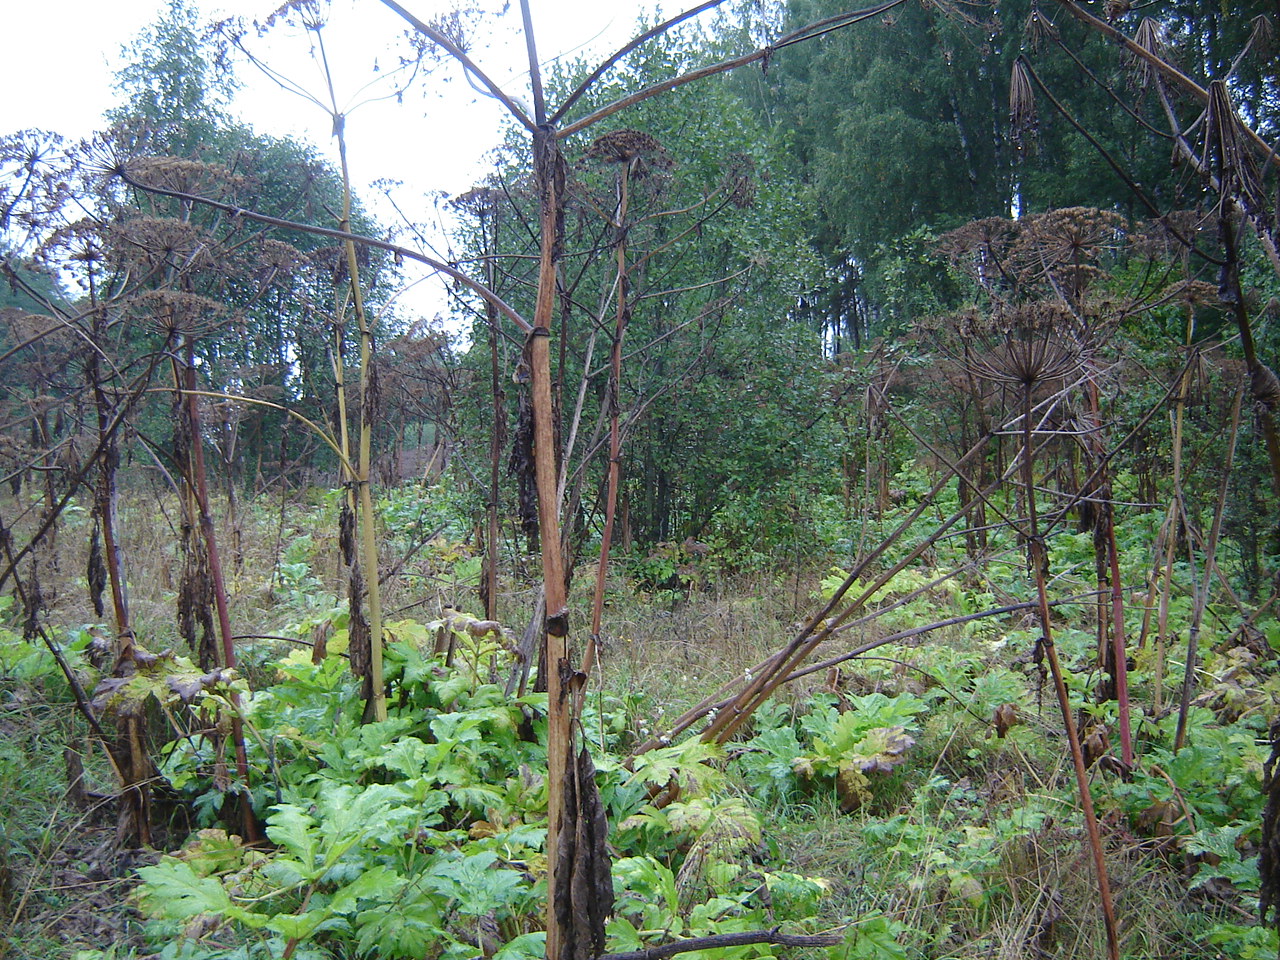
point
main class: Woodland
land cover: Pine dominated mixed woodland
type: hemiboreal forest and nemoral coniferous forest and mixed broadleaved-coniferous forest
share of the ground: > 75 %
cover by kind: broadleaved forest trees 55 %, coniferous forest trees 30 %, herbaceous plants 15 %
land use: Forestry
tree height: > 5 m
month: September
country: LT
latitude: 54.9976
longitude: 25.3638
